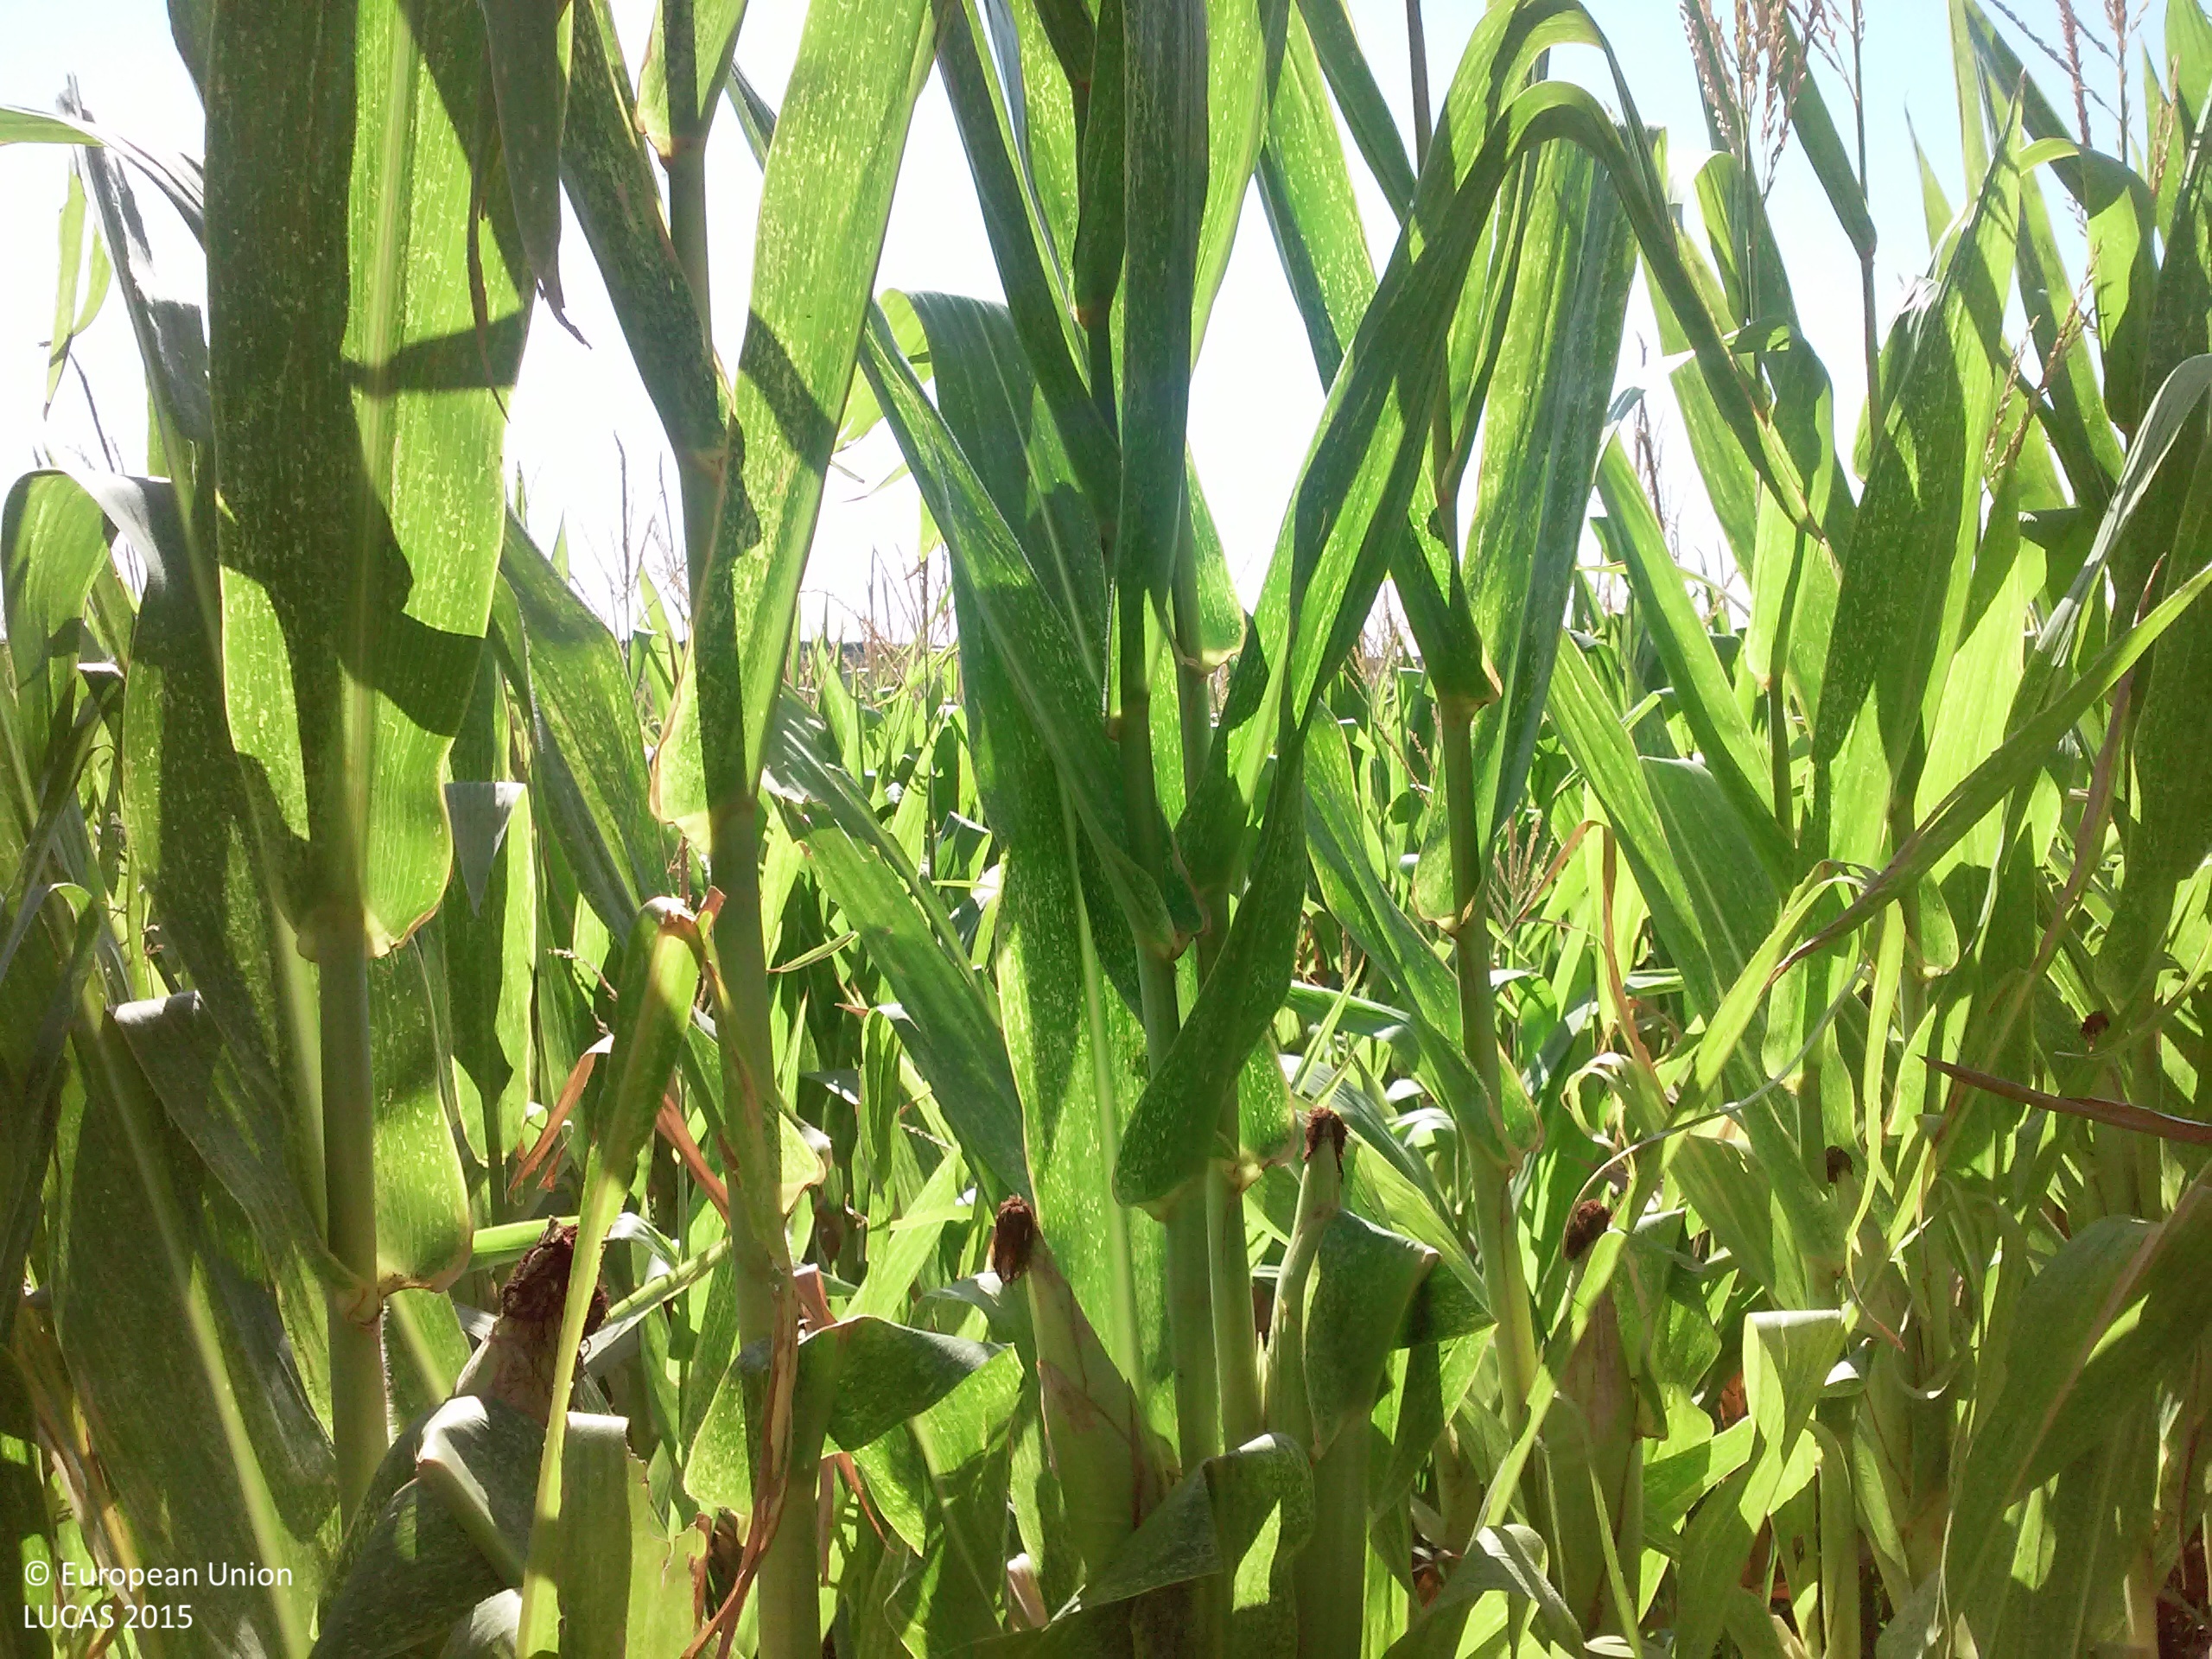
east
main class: Cropland
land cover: Maize
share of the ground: > 75 %
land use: Agriculture (excluding fallow land and kitchen gardens)
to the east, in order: Maize; Shrubland with sparse tree cover; Other bare soil; Shruby margins; Other bare soil; Grass margins; Grassland with sparse tree/shrub cover; Other fruit trees and berries; Grassland without tree/shrub cover
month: July
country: ES
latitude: 41.6960
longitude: 0.6751
